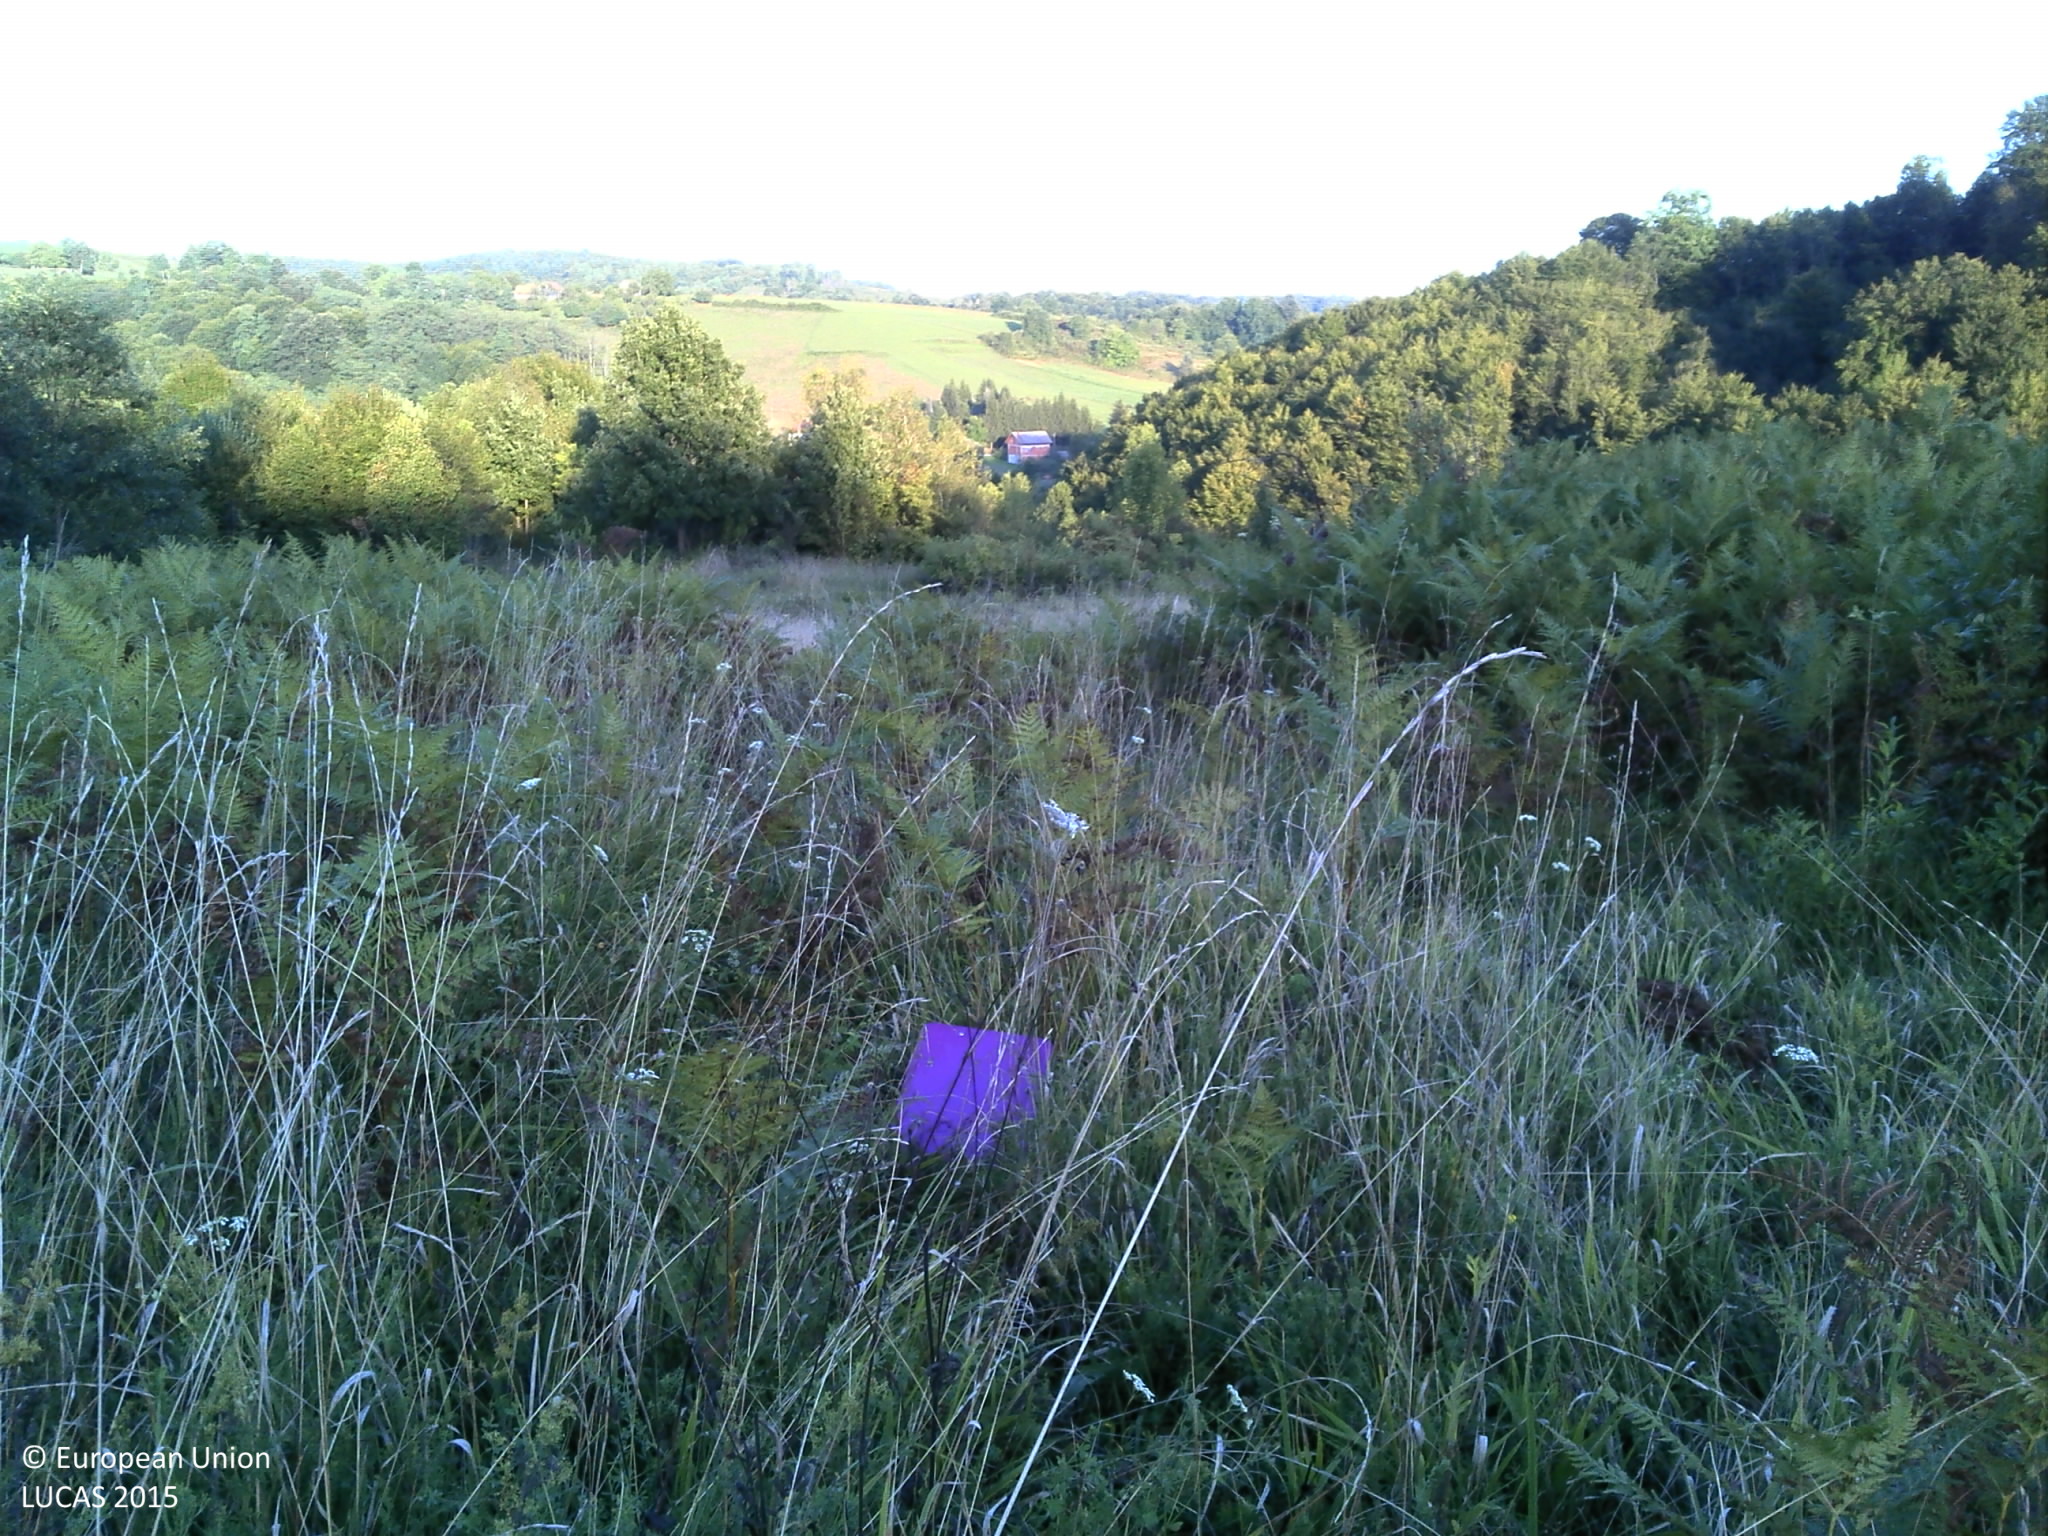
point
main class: Grassland
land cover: Grassland with sparse tree/shrub cover
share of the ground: > 75 %
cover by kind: herbaceous plants 85 %, shrubs 10 %, broadleaved forest trees 5 %
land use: Semi-natural and natural areas not in use
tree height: < 5 m
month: August
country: HR
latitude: 45.2826
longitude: 15.6179
